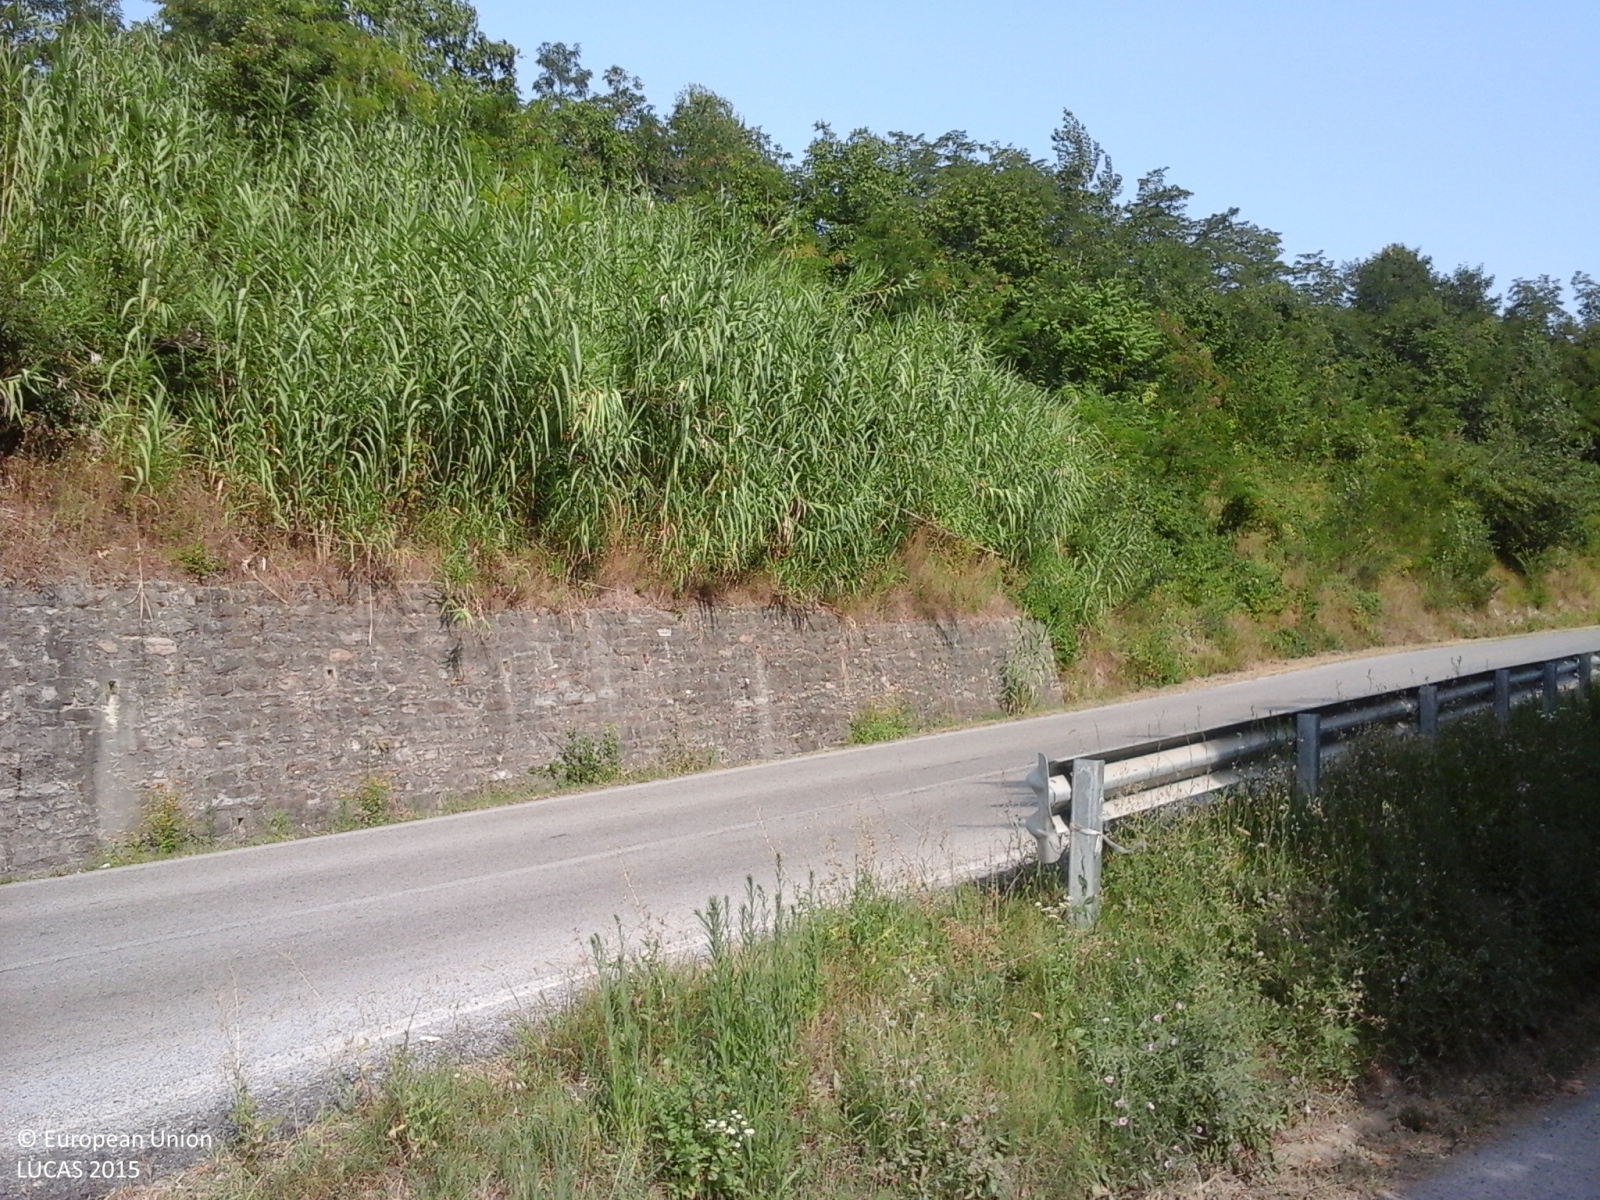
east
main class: Cropland
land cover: Nuts trees
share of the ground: 50 - 75 %
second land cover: Grassland without tree/shrub cover
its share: 50 - 75 %
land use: Agriculture (excluding fallow land and kitchen gardens)
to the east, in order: Nuts trees; Grassland without tree/shrub cover; Broadleaved woodland; Tracks; Grass margins; Paved roads, cycling and walking lanes; Ditches and canals; Broadleaved woodland; Paved roads, cycling and walking lanes; Shrubland with sparse tree cover; Grassland without tree/shrub cover; Electric lines; Grassland without tree/shrub cover; Artificial constructions in urban areas; Grassland without tree/shrub cover
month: July
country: IT
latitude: 44.6389
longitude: 8.0499
